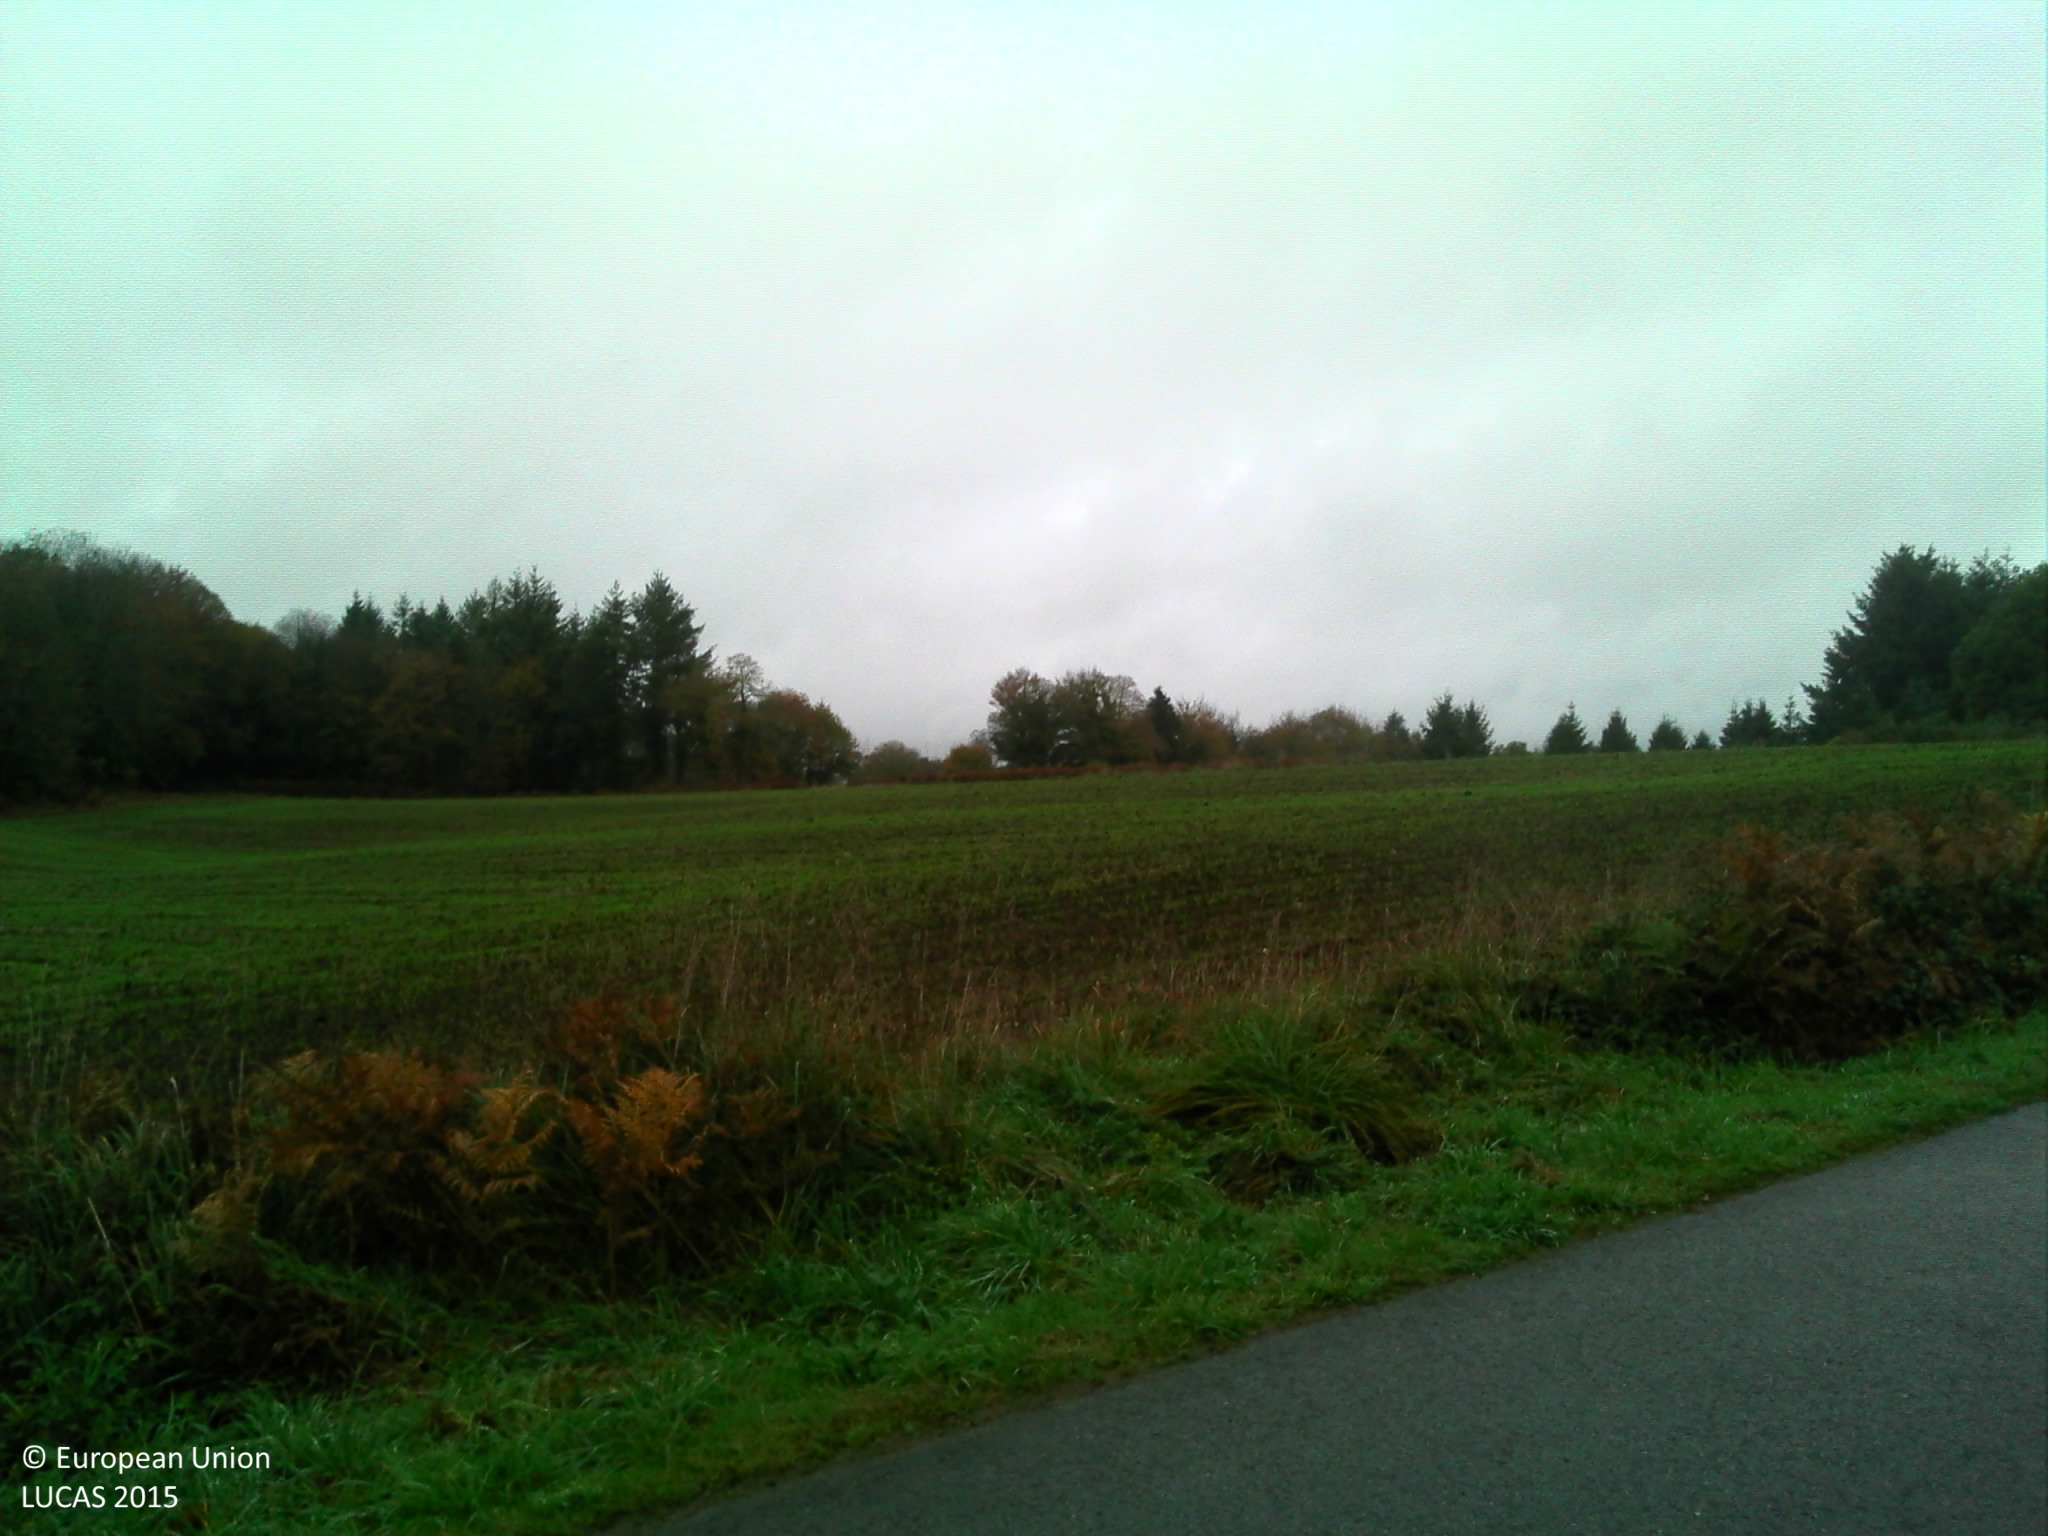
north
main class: Cropland
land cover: Maize
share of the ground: > 75 %
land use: Agriculture (excluding fallow land and kitchen gardens)
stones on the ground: < 10 %
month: November
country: FR
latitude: 47.9437
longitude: -3.2865
